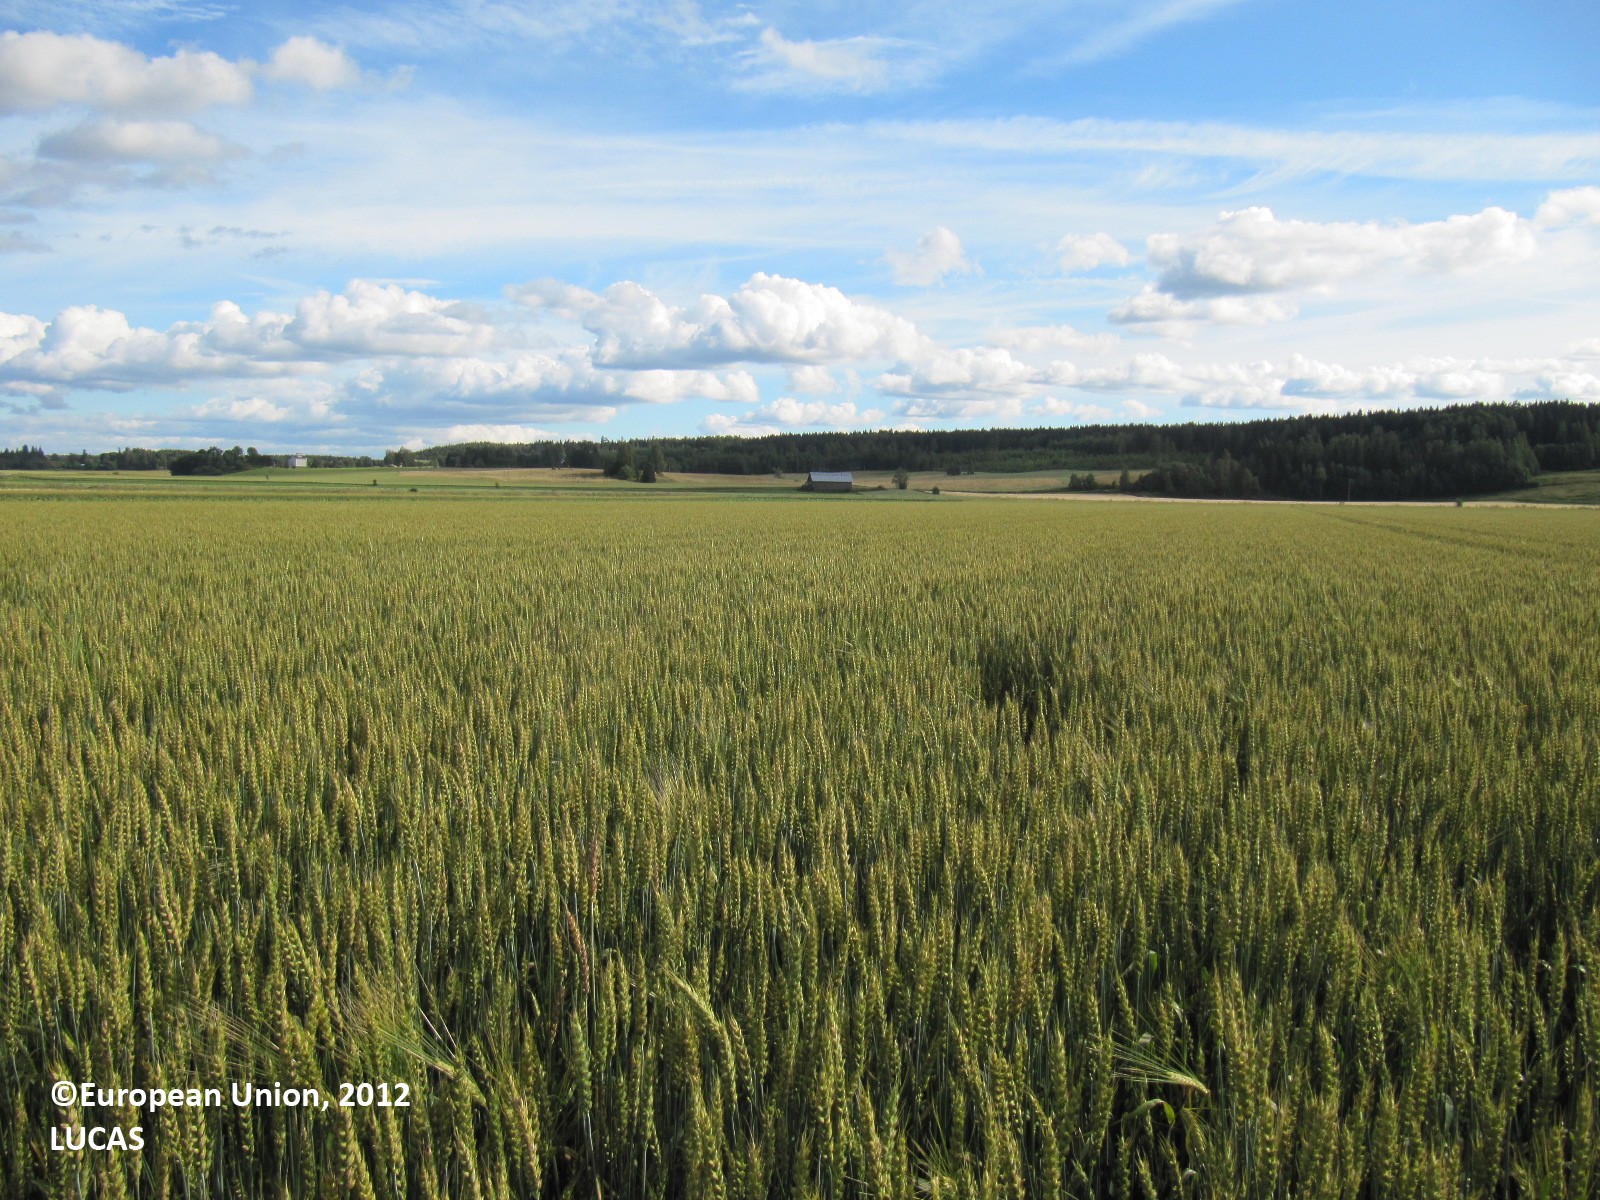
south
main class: Cropland
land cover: Common wheat
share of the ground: > 75 %
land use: Agriculture (excluding fallow land and kitchen gardens)
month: August
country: FI
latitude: 60.3240
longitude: 23.2107
